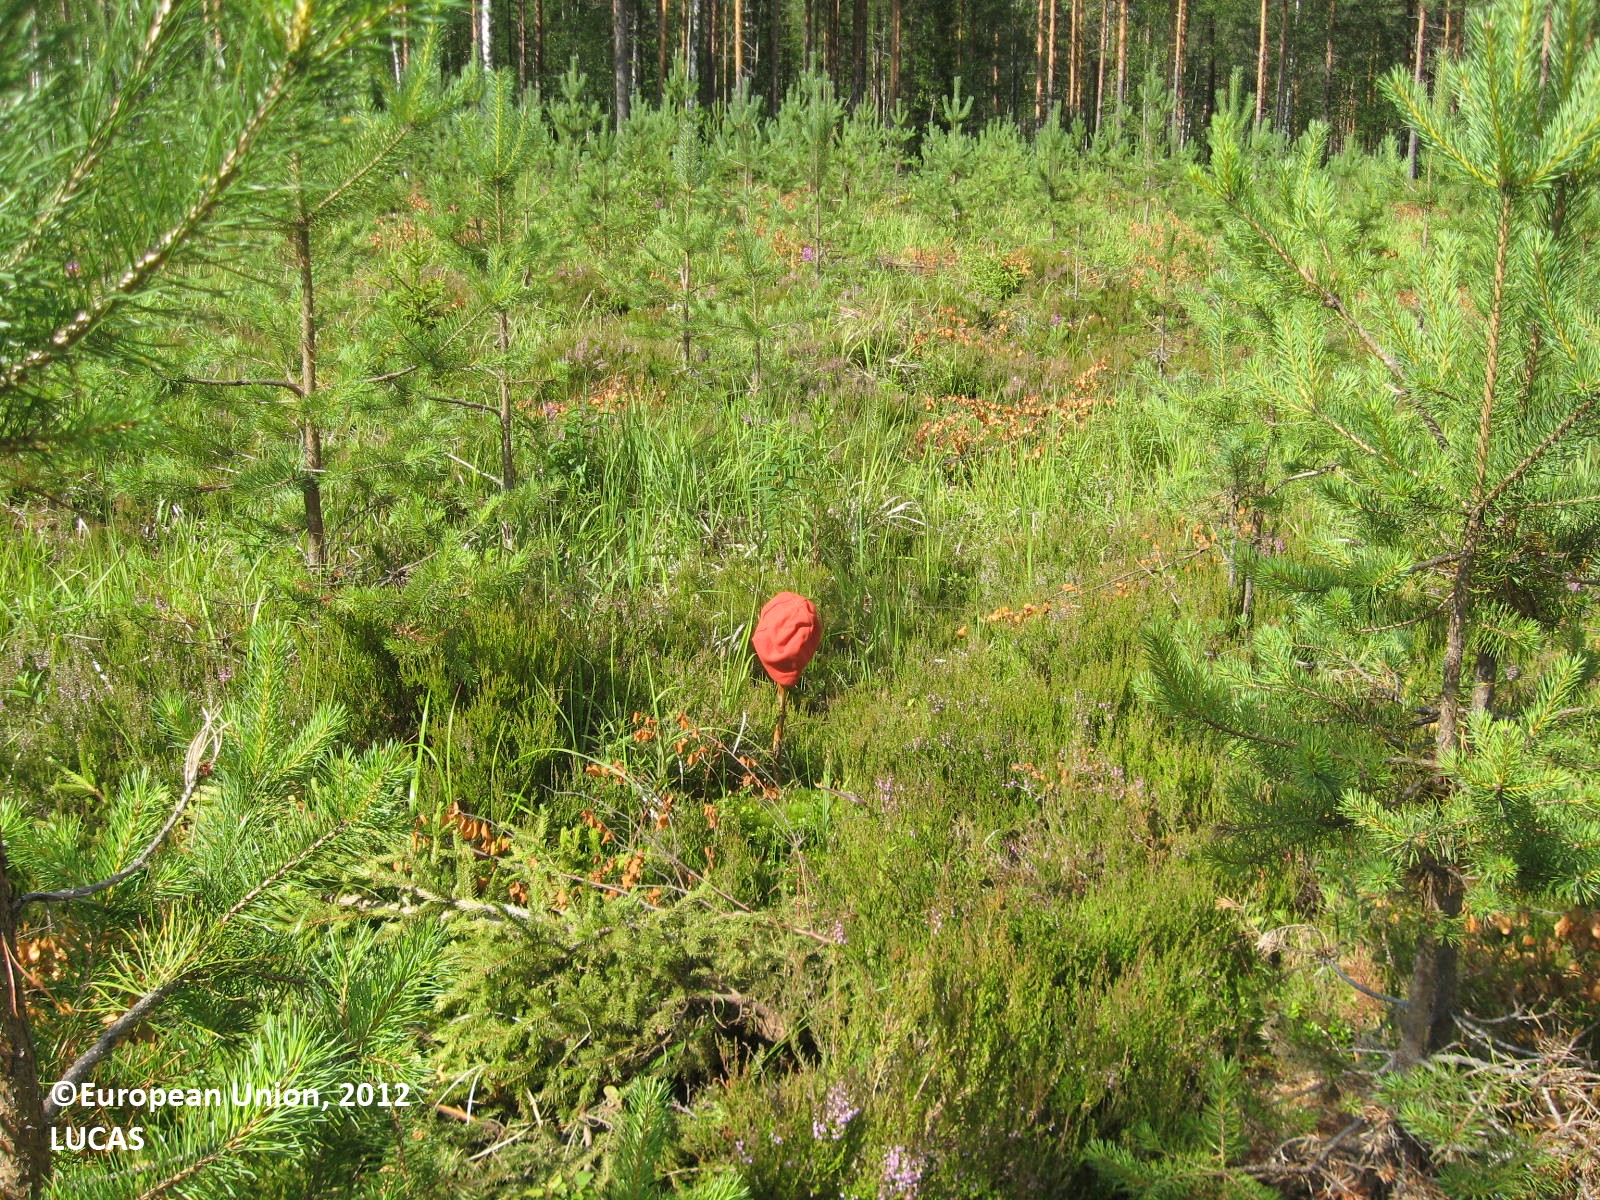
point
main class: Woodland
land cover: Pine dominated coniferous woodland
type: boreal forest
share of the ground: 25 - 50 %
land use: Forestry
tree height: < 5 m
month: July
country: FI
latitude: 62.0002
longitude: 22.6834
